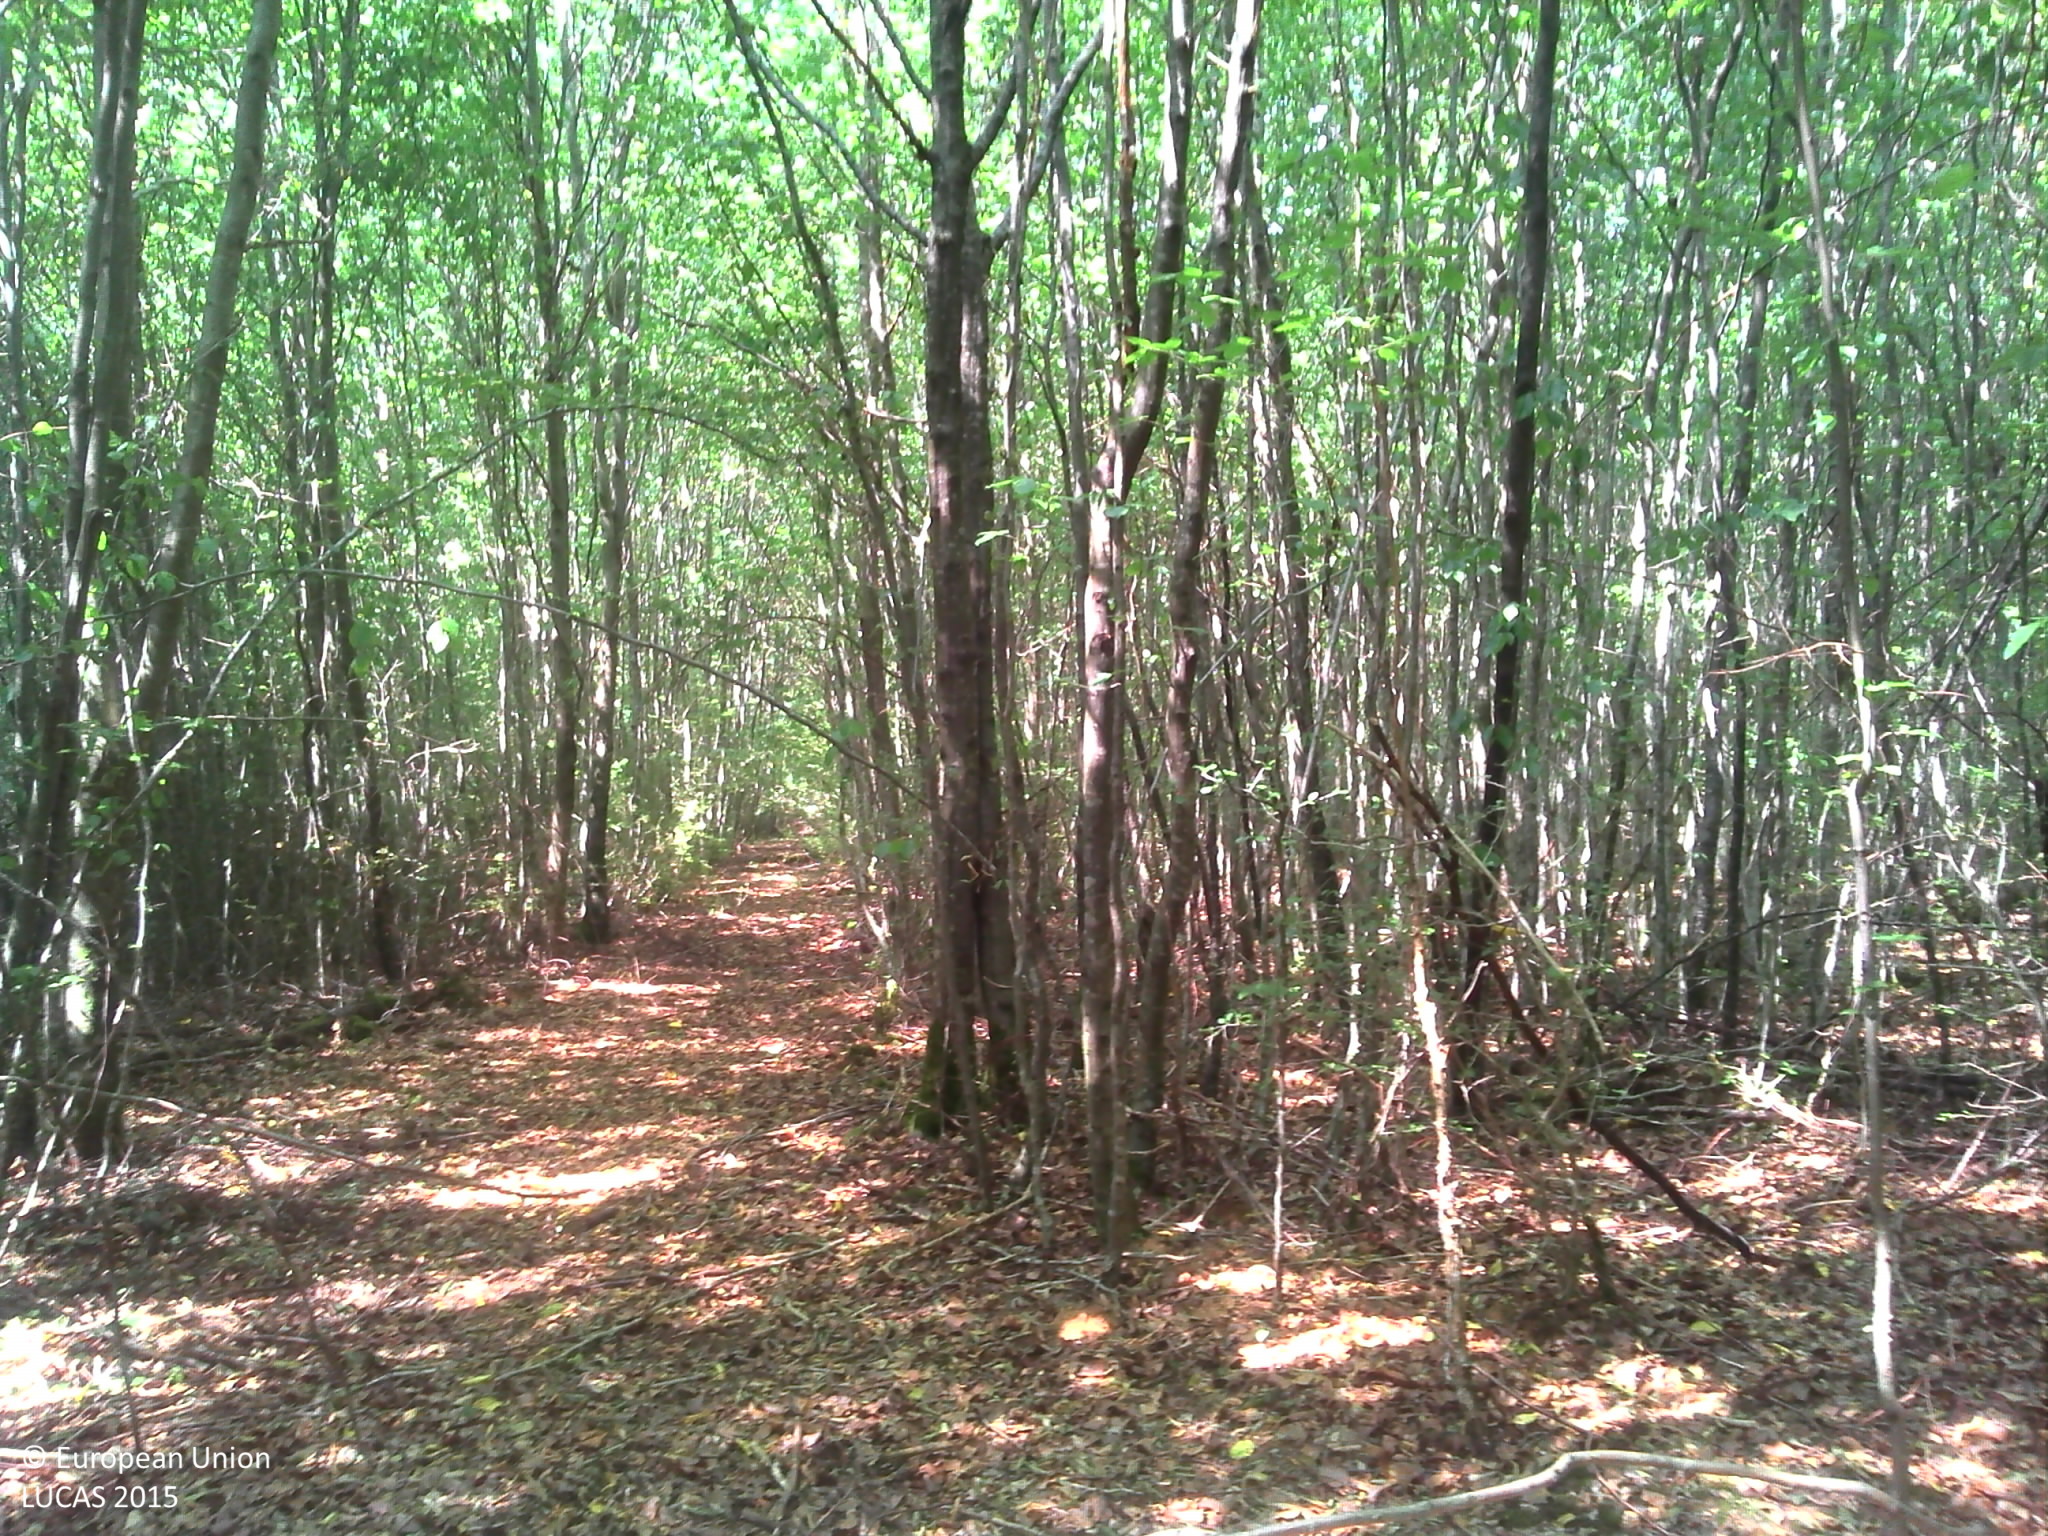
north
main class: Woodland
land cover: Broadleaved woodland
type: beech forest
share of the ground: > 75 %
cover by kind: broadleaved forest trees 90 %, shrubs 5 %, herbaceous plants 5 %
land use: Forestry
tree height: > 5 m
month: July
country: FR
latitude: 47.9852
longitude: 5.0283
